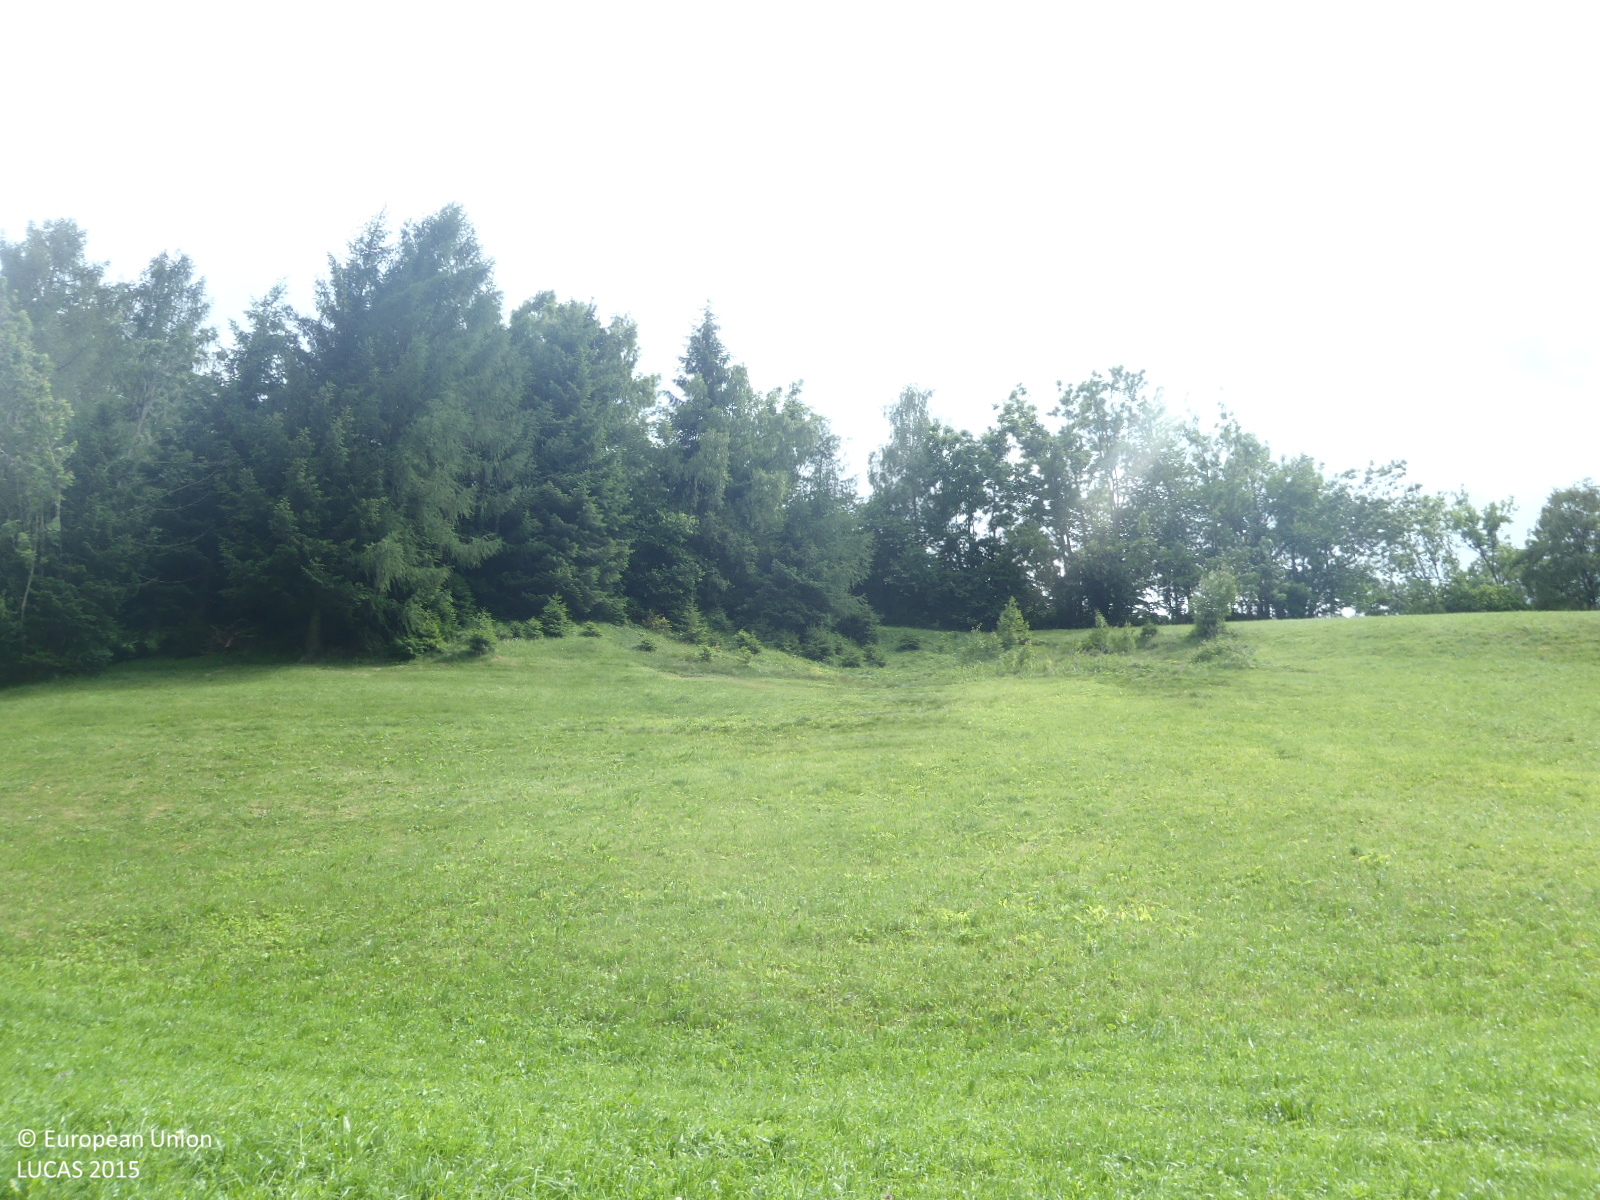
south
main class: Grassland
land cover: Grassland without tree/shrub cover
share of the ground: > 75 %
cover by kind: herbaceous plants 100 %
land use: Agriculture (excluding fallow land and kitchen gardens)
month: June
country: AT
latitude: 47.1157
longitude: 11.4615
